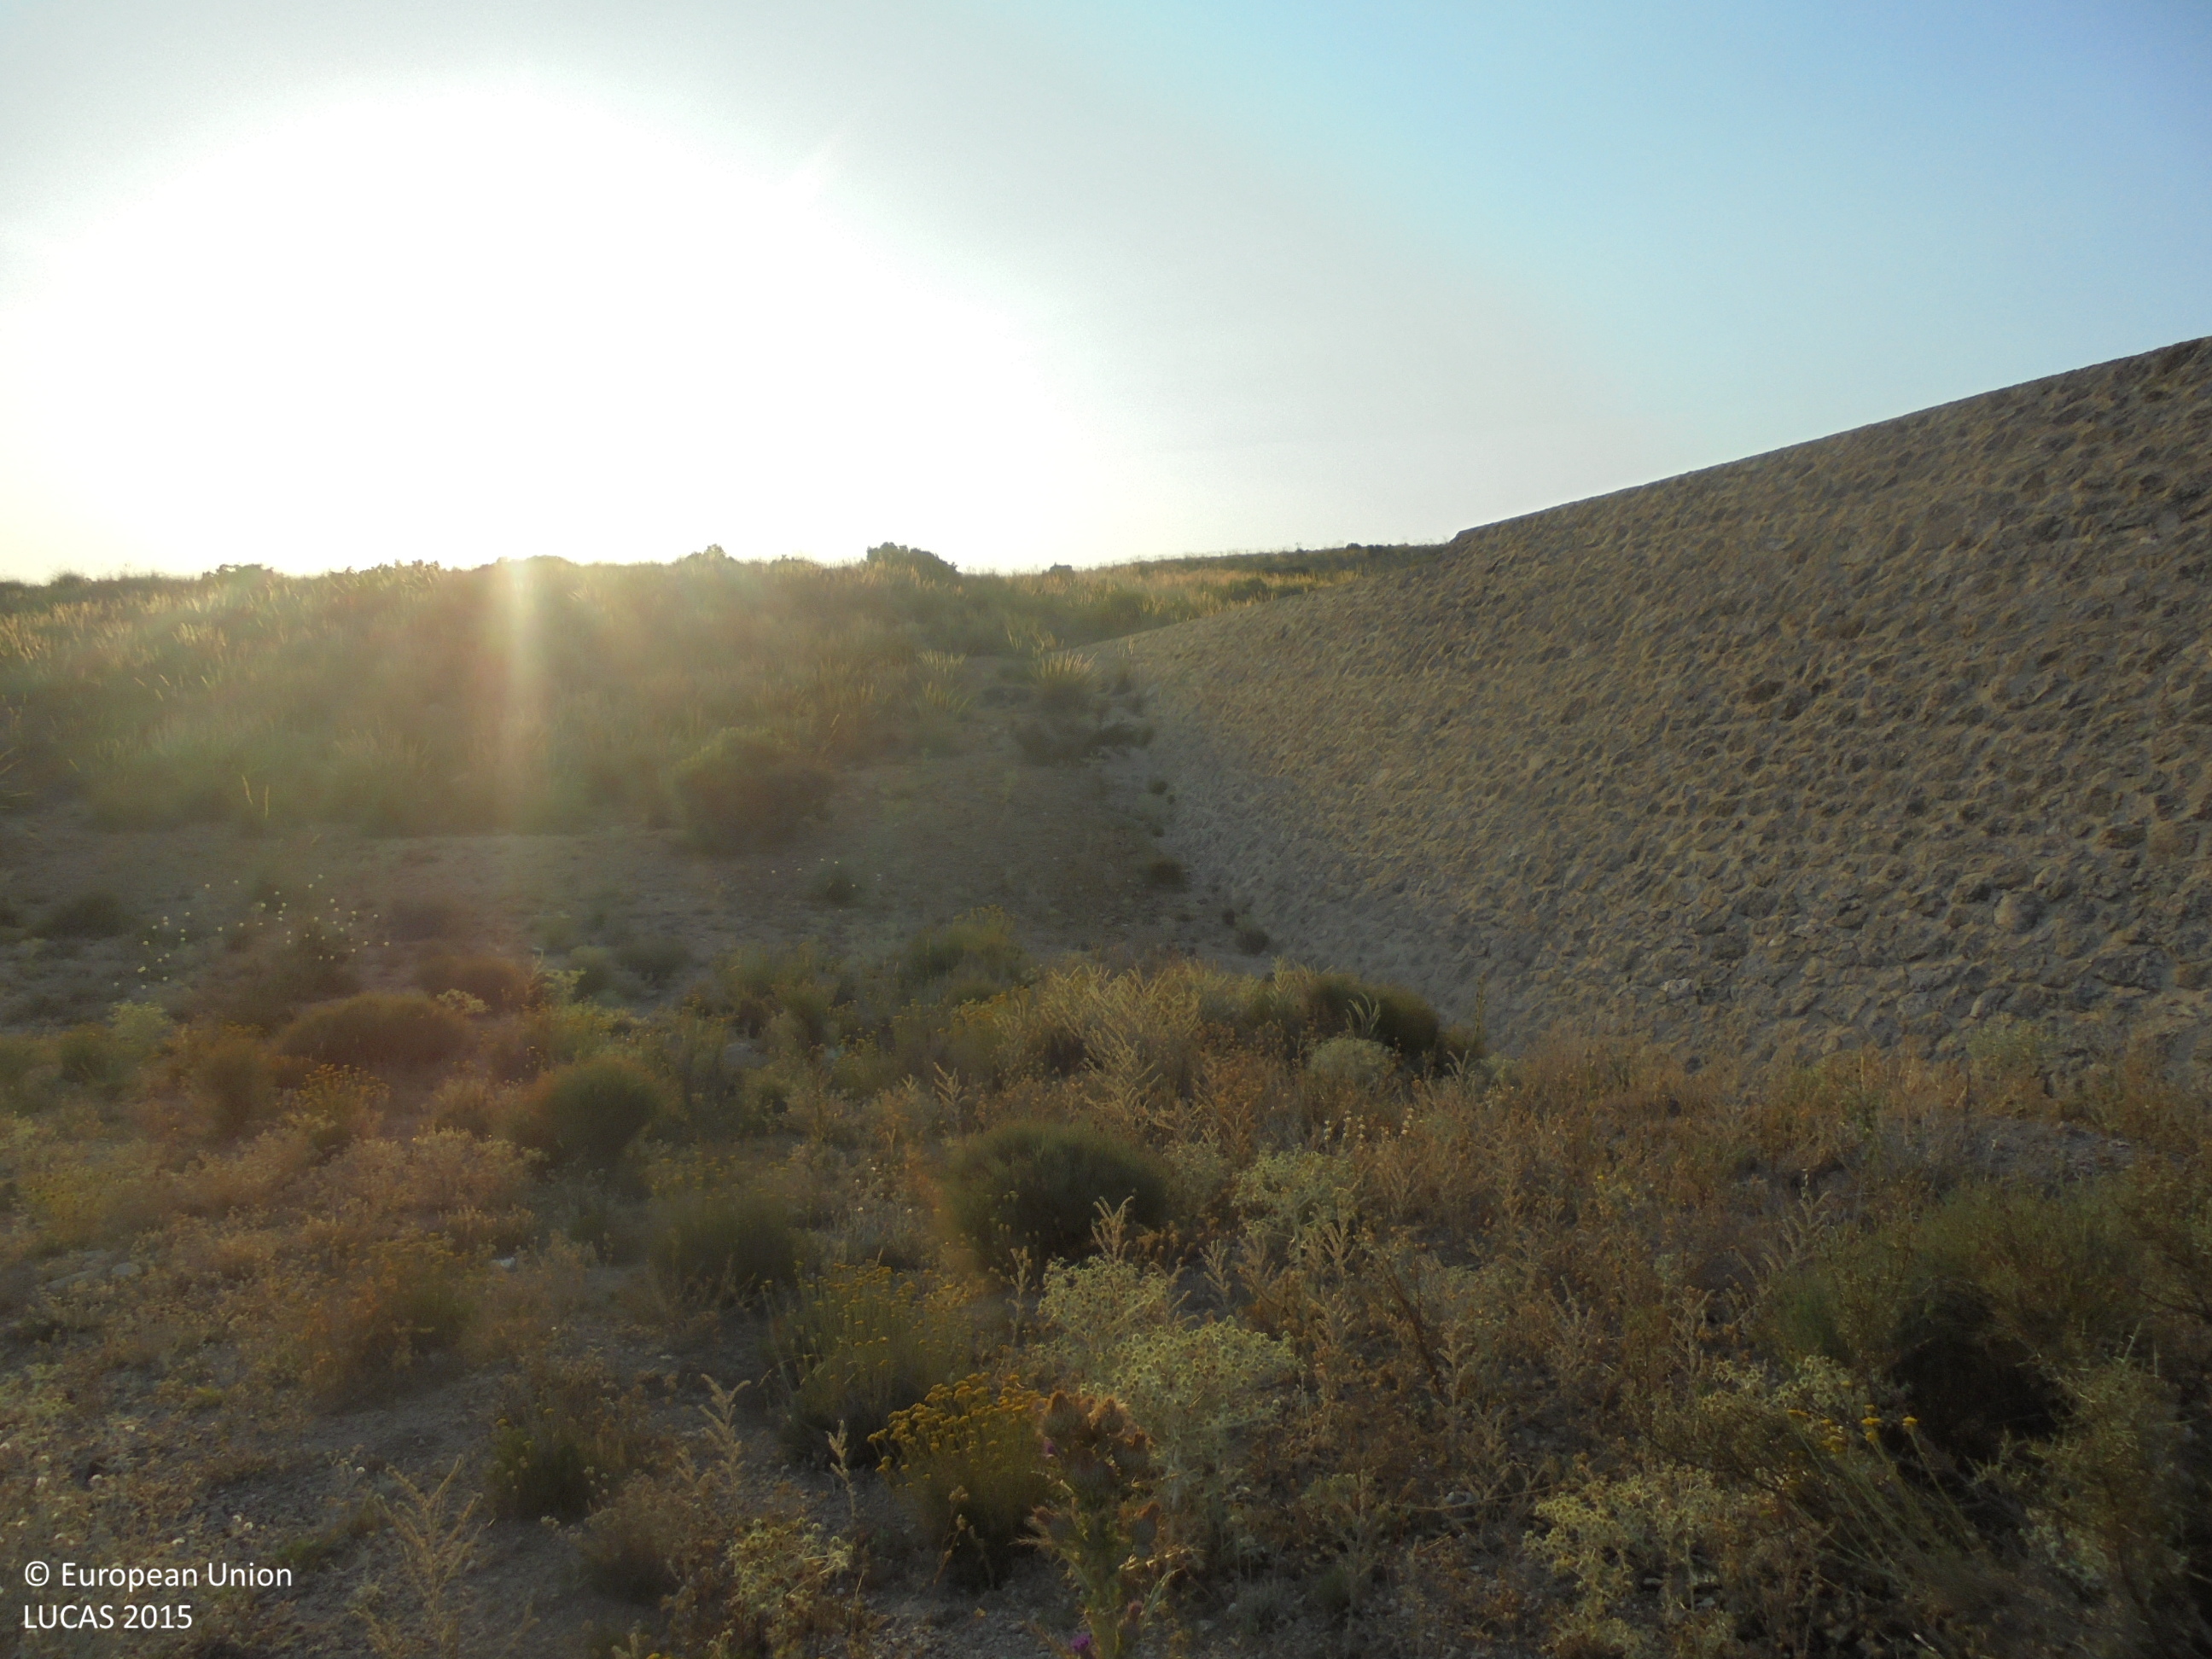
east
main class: Shrubland
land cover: Shrubland without tree cover
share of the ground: 25 - 50 %
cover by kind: herbaceous plants 40 %, shrubs 30 %, unconsolidated bare surface 30 %
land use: Semi-natural and natural areas not in use
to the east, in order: Shrubland without tree cover; Dry stone walls; Shrubland without tree cover
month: July
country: ES
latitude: 38.7041
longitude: -1.4124
